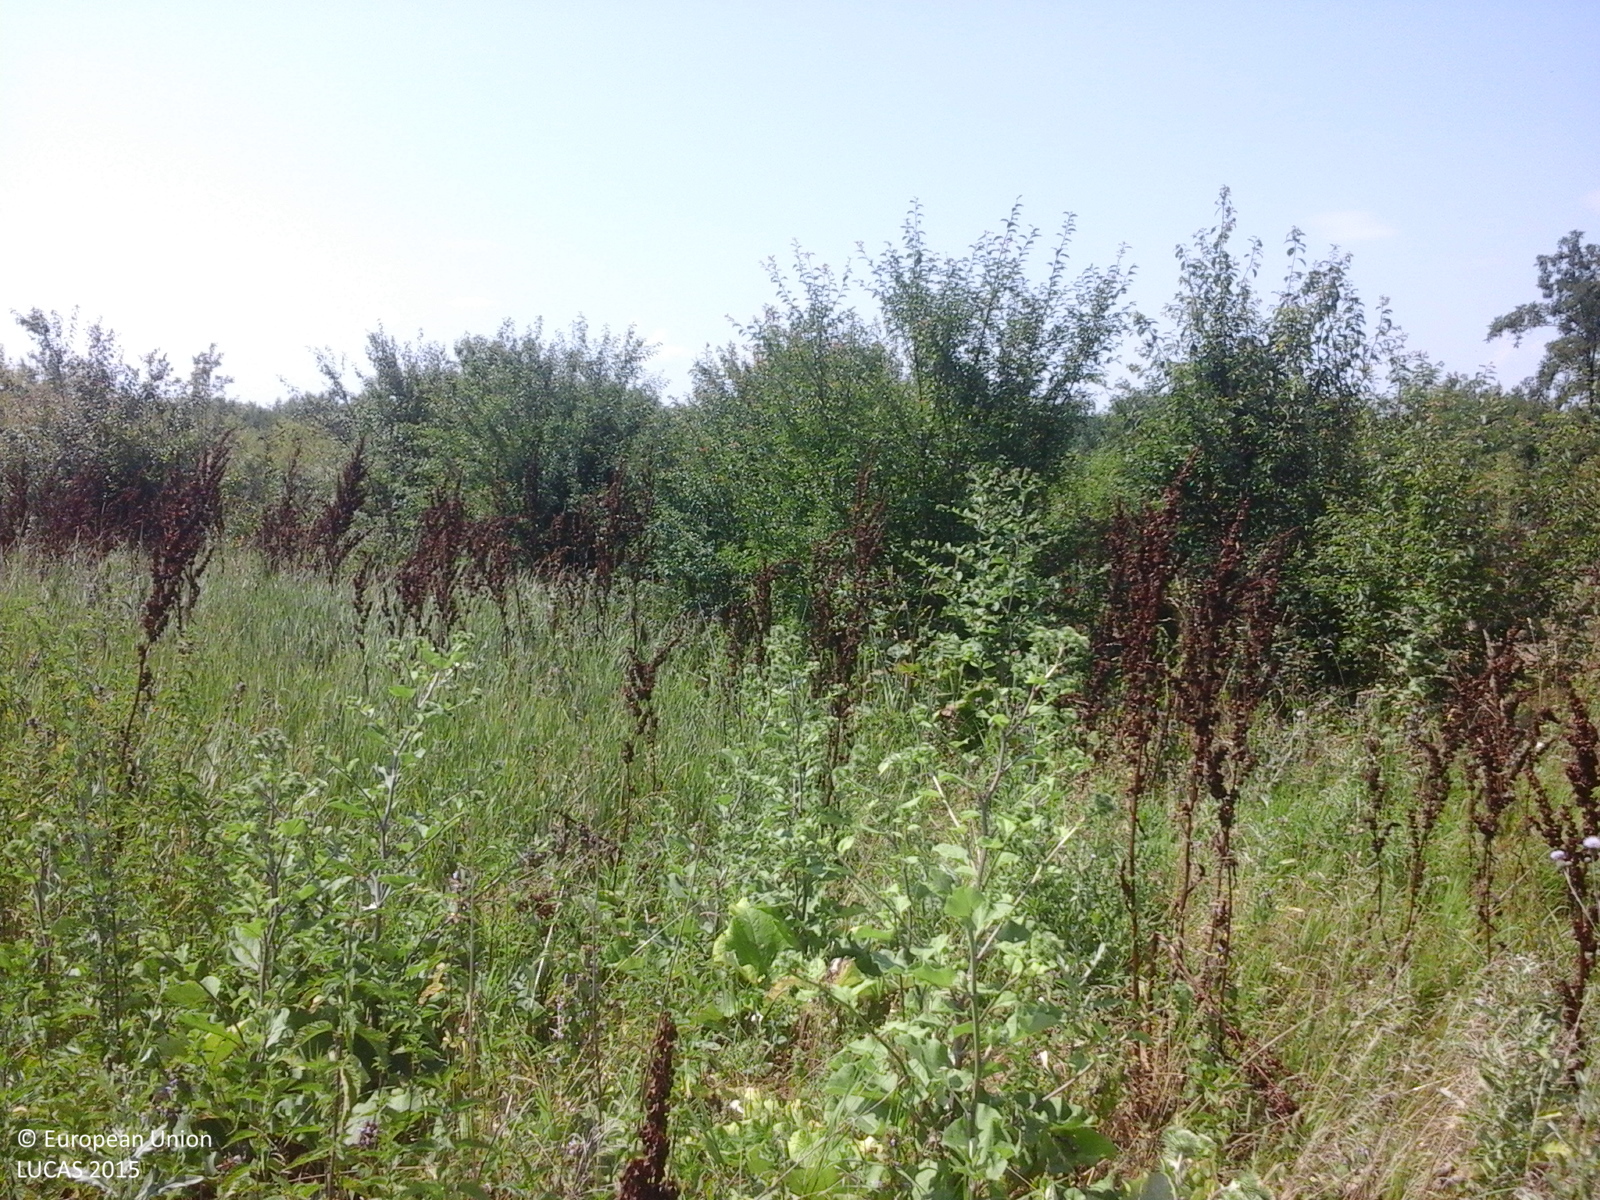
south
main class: Grassland
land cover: Grassland with sparse tree/shrub cover
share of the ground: > 75 %
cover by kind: herbaceous plants 85 %, shrubs 10 %, broadleaved forest trees 5 %
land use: Semi-natural and natural areas not in use
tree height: < 5 m
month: July
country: RO
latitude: 44.1741
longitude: 25.8177
